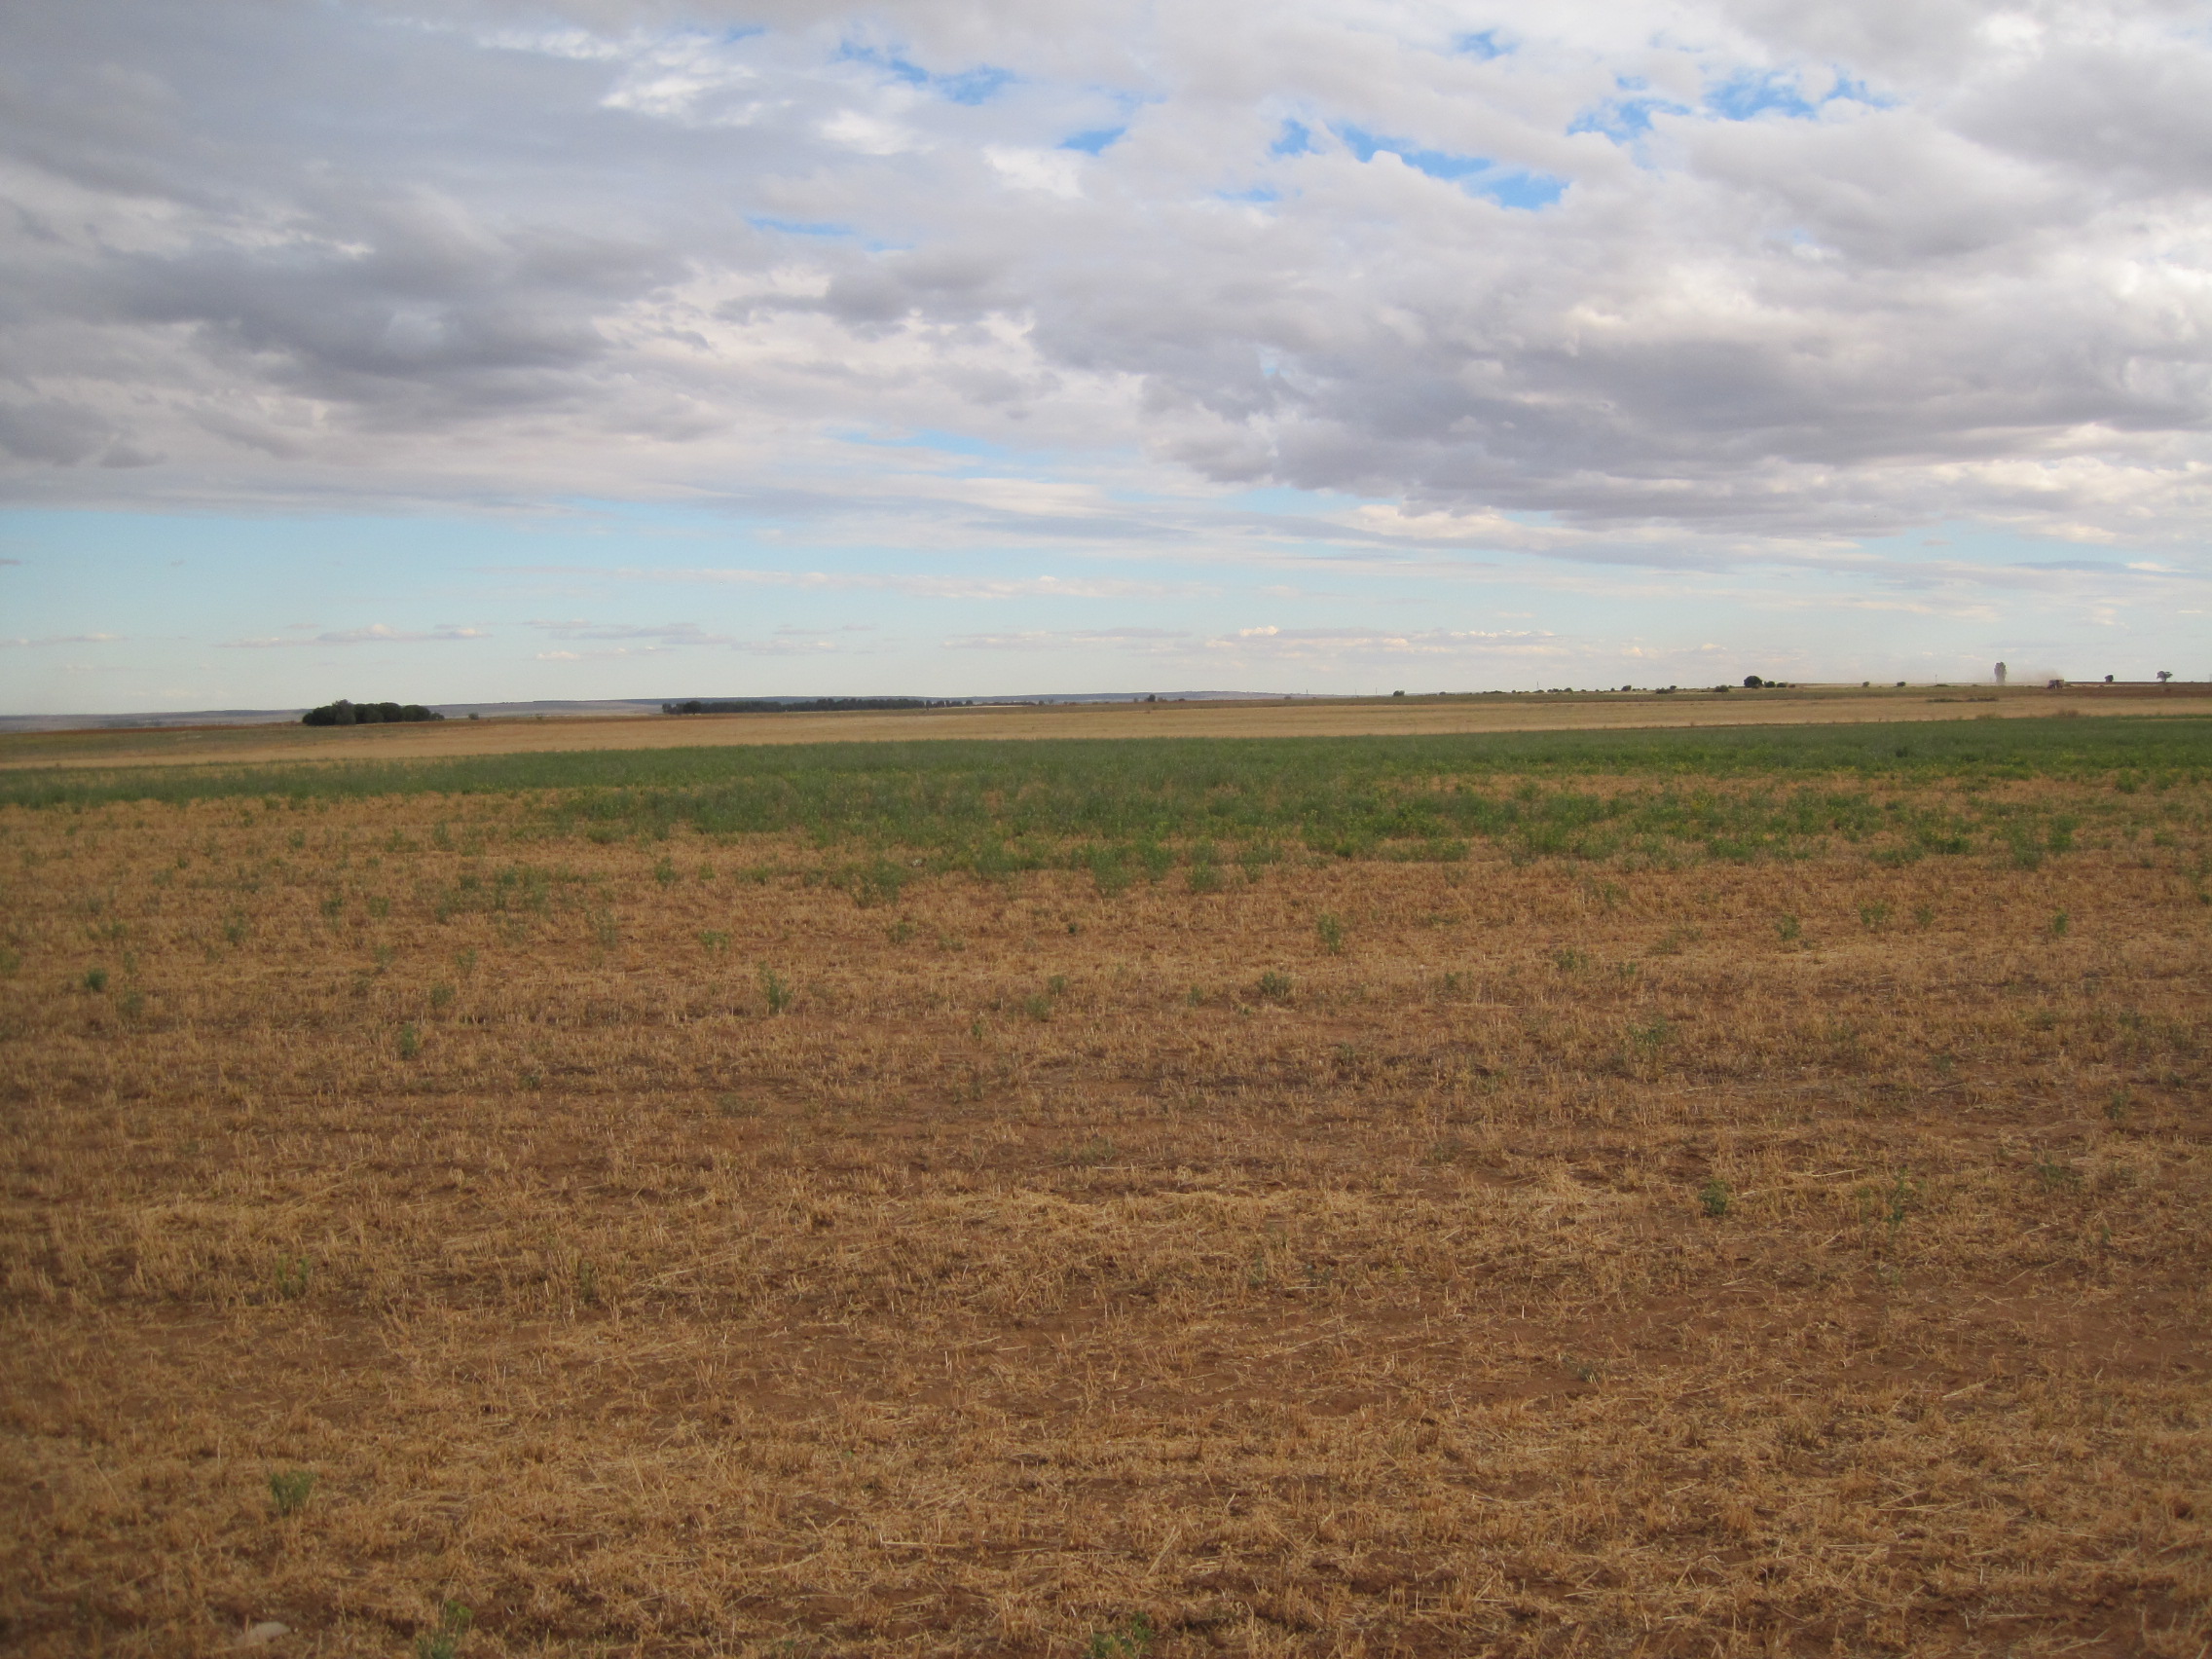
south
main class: Cropland
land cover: Lucerne
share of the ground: < 10 %
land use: Agriculture (excluding fallow land and kitchen gardens)
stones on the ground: 10 - 25 %
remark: Harvested field
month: July
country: ES
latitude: 41.9390
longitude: -5.4402
